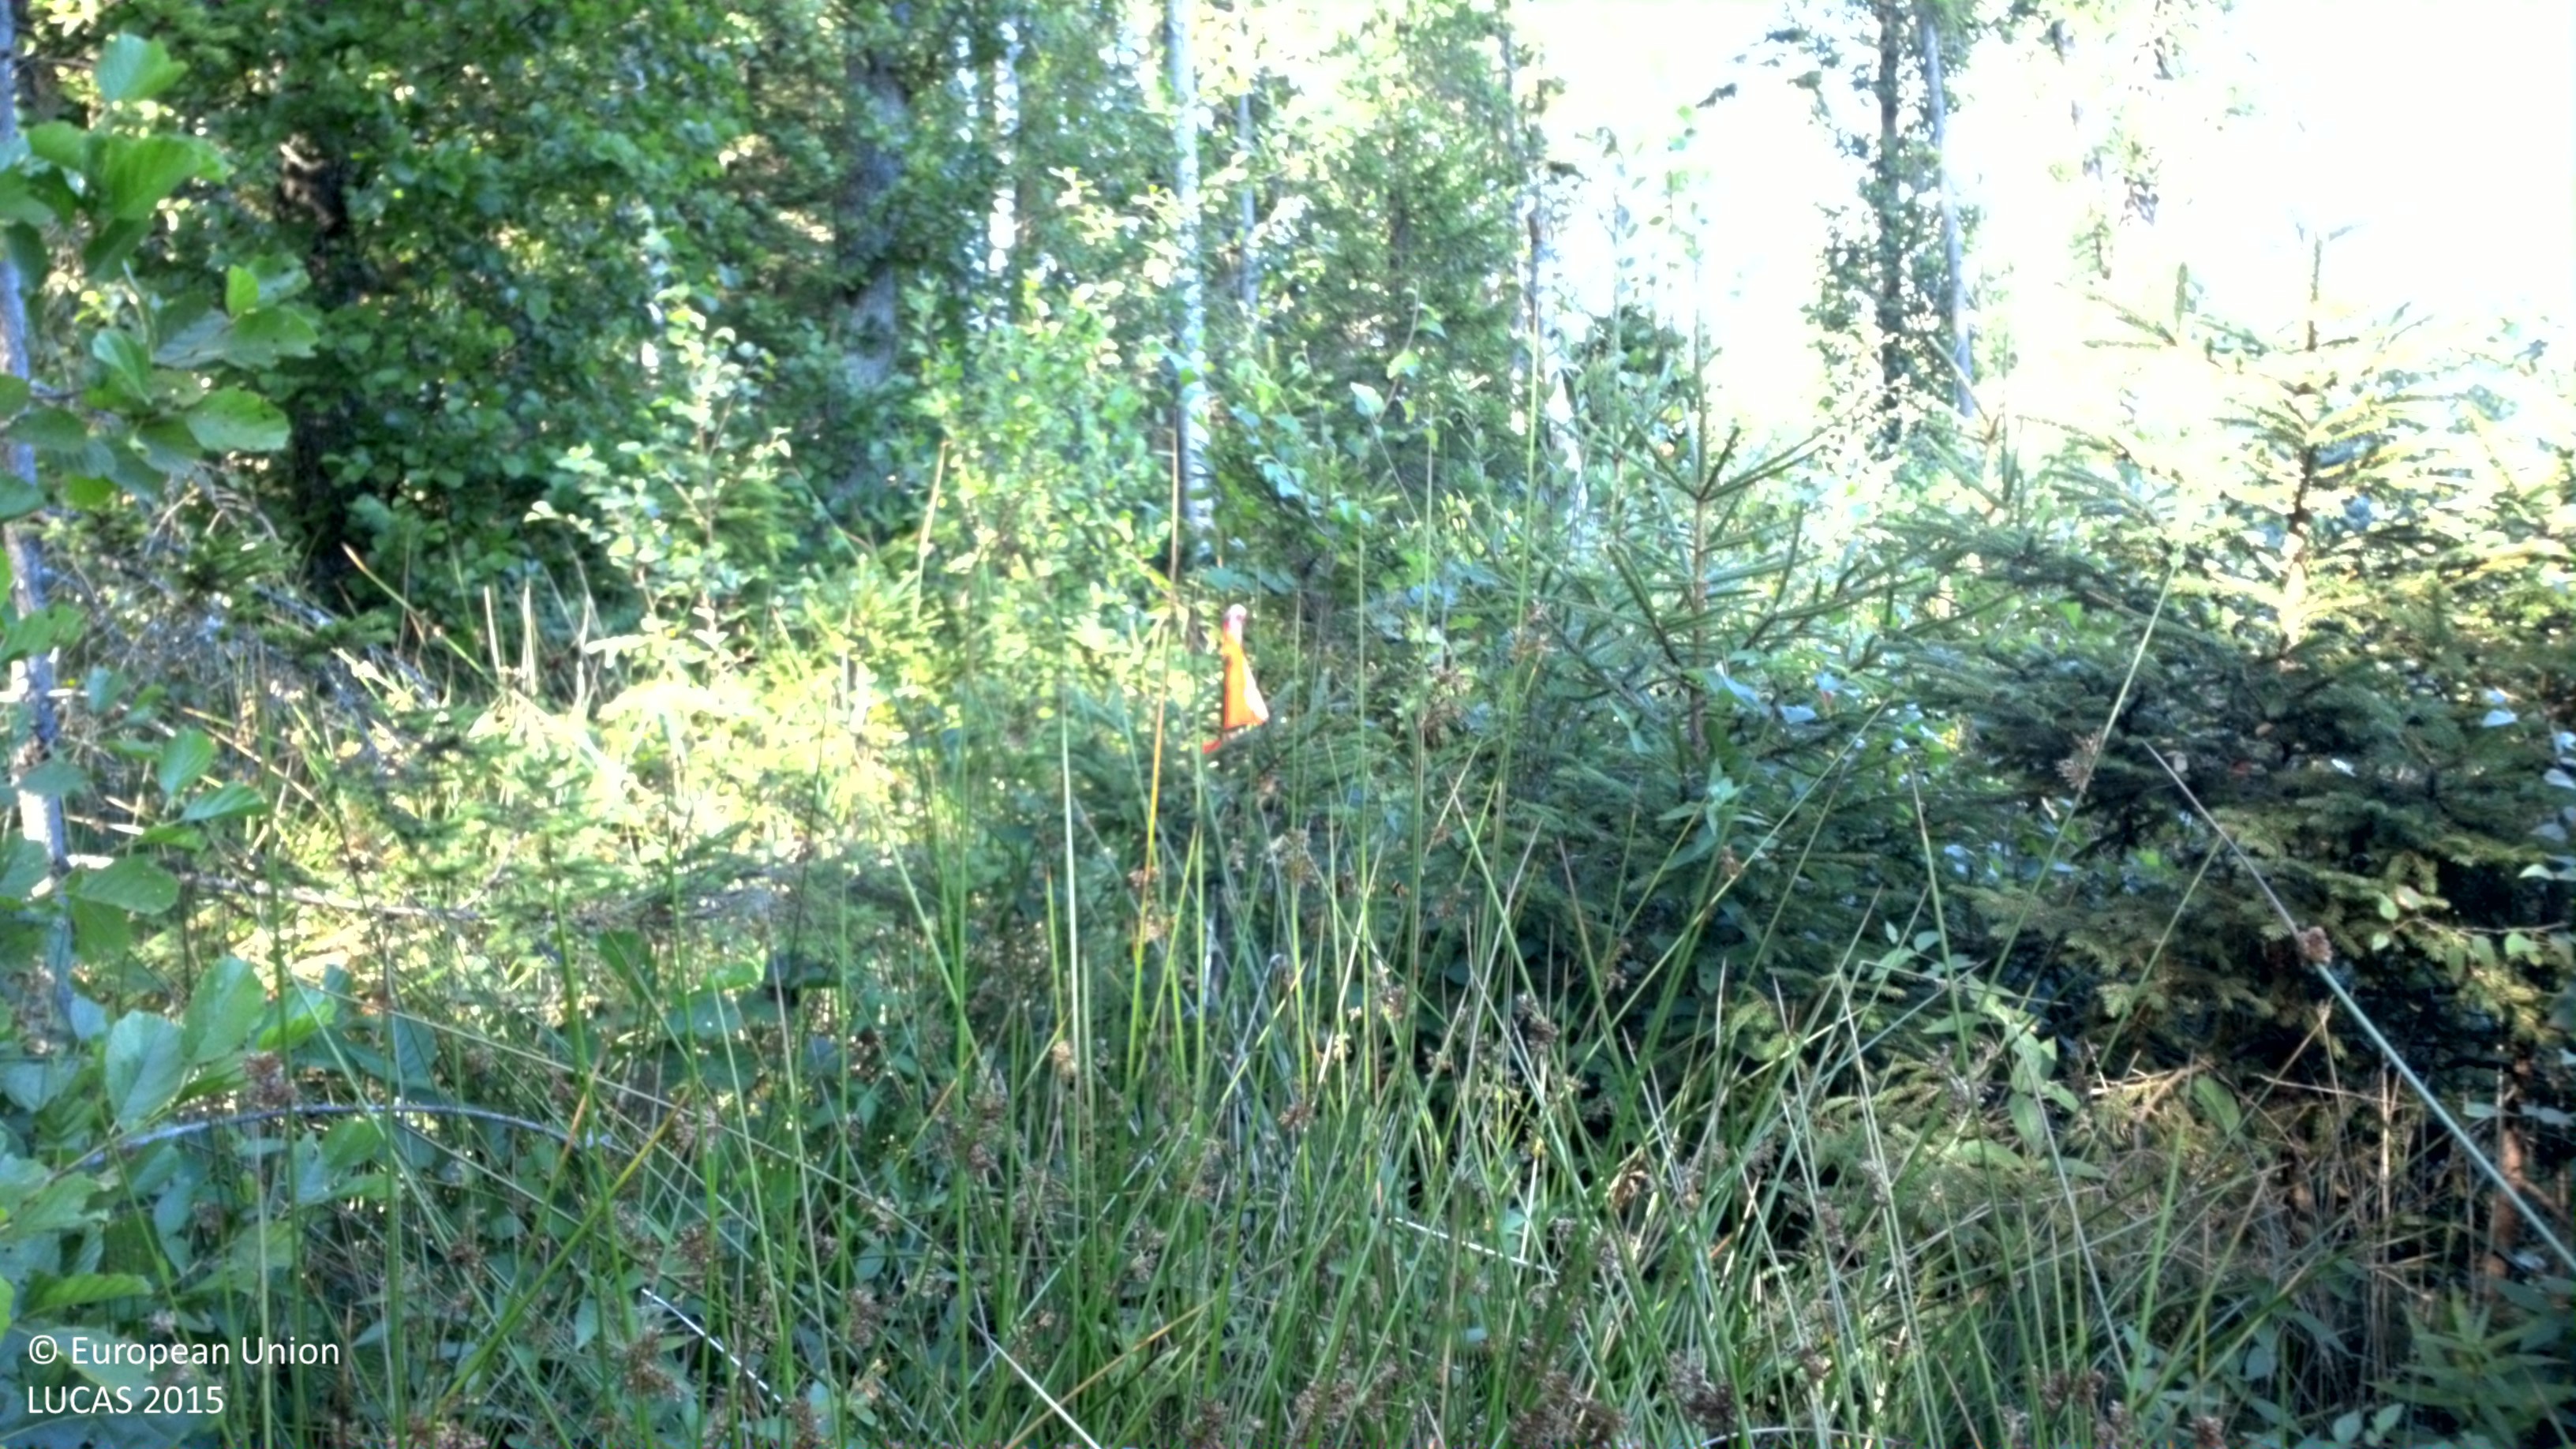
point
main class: Woodland
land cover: Spruce dominated mixed woodland
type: hemiboreal forest and nemoral coniferous forest and mixed broadleaved-coniferous forest
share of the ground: > 75 %
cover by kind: coniferous forest trees 50 %, broadleaved forest trees 25 %, herbaceous plants 20 %, shrubs 5 %
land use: Forestry
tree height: > 5 m
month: August
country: SE
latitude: 56.2979
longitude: 15.2183
